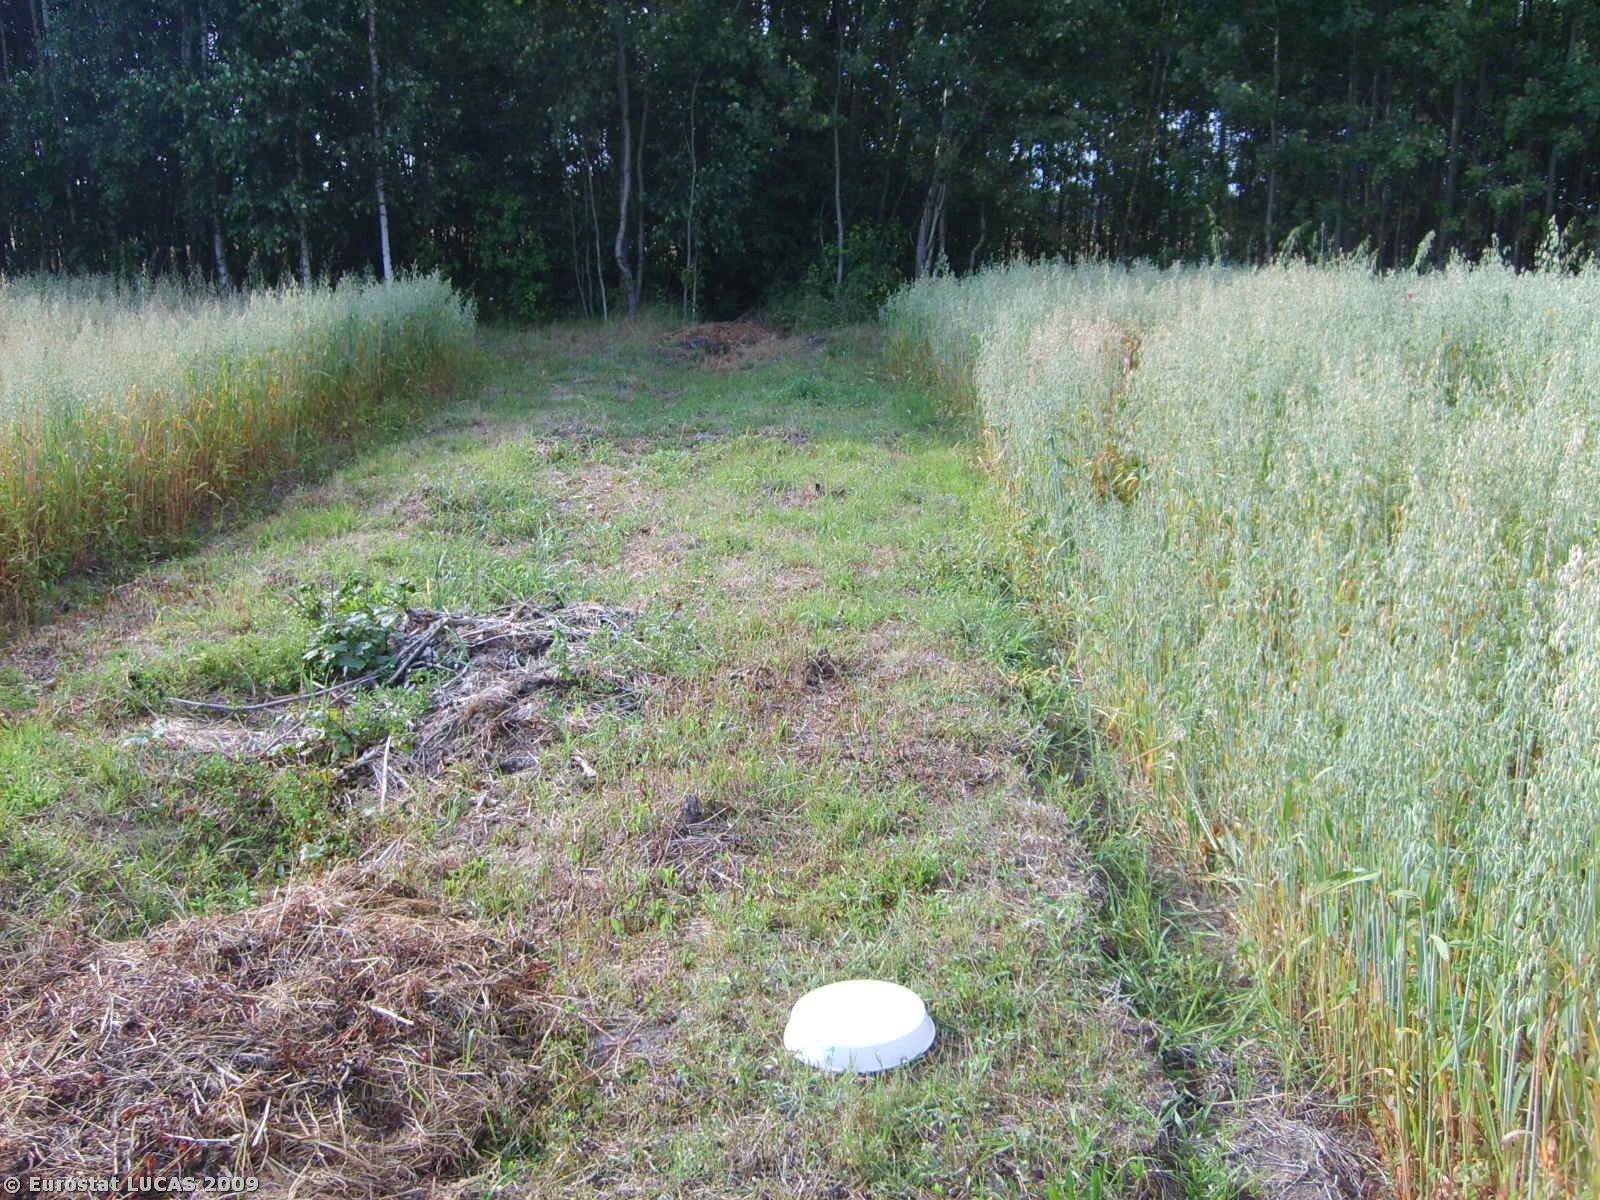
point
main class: Grassland
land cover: Grassland without tree/shrub cover
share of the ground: > 75 %
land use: Unused
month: July
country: PL
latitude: 52.4486
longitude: 21.7220
